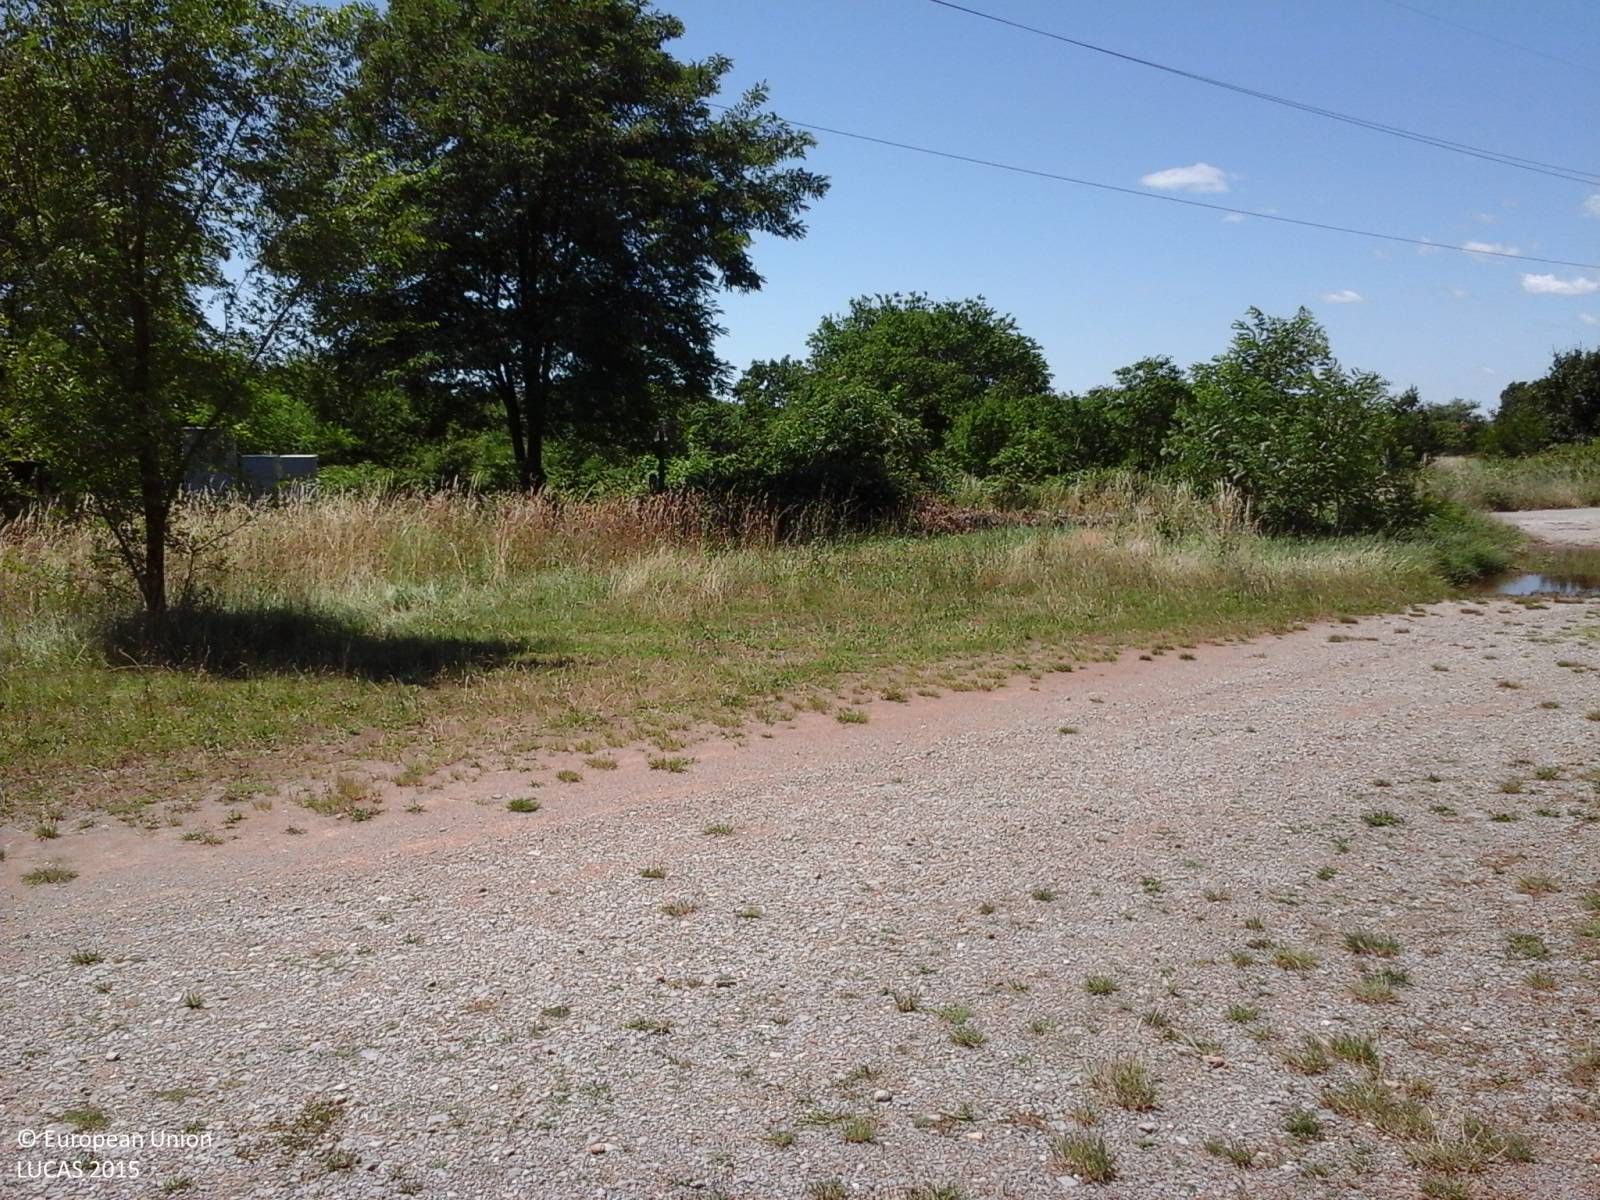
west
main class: Cropland
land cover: Other fresh vegetables
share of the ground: > 75 %
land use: Kitchen garden
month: June
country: IT
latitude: 45.7648
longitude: 13.6861
